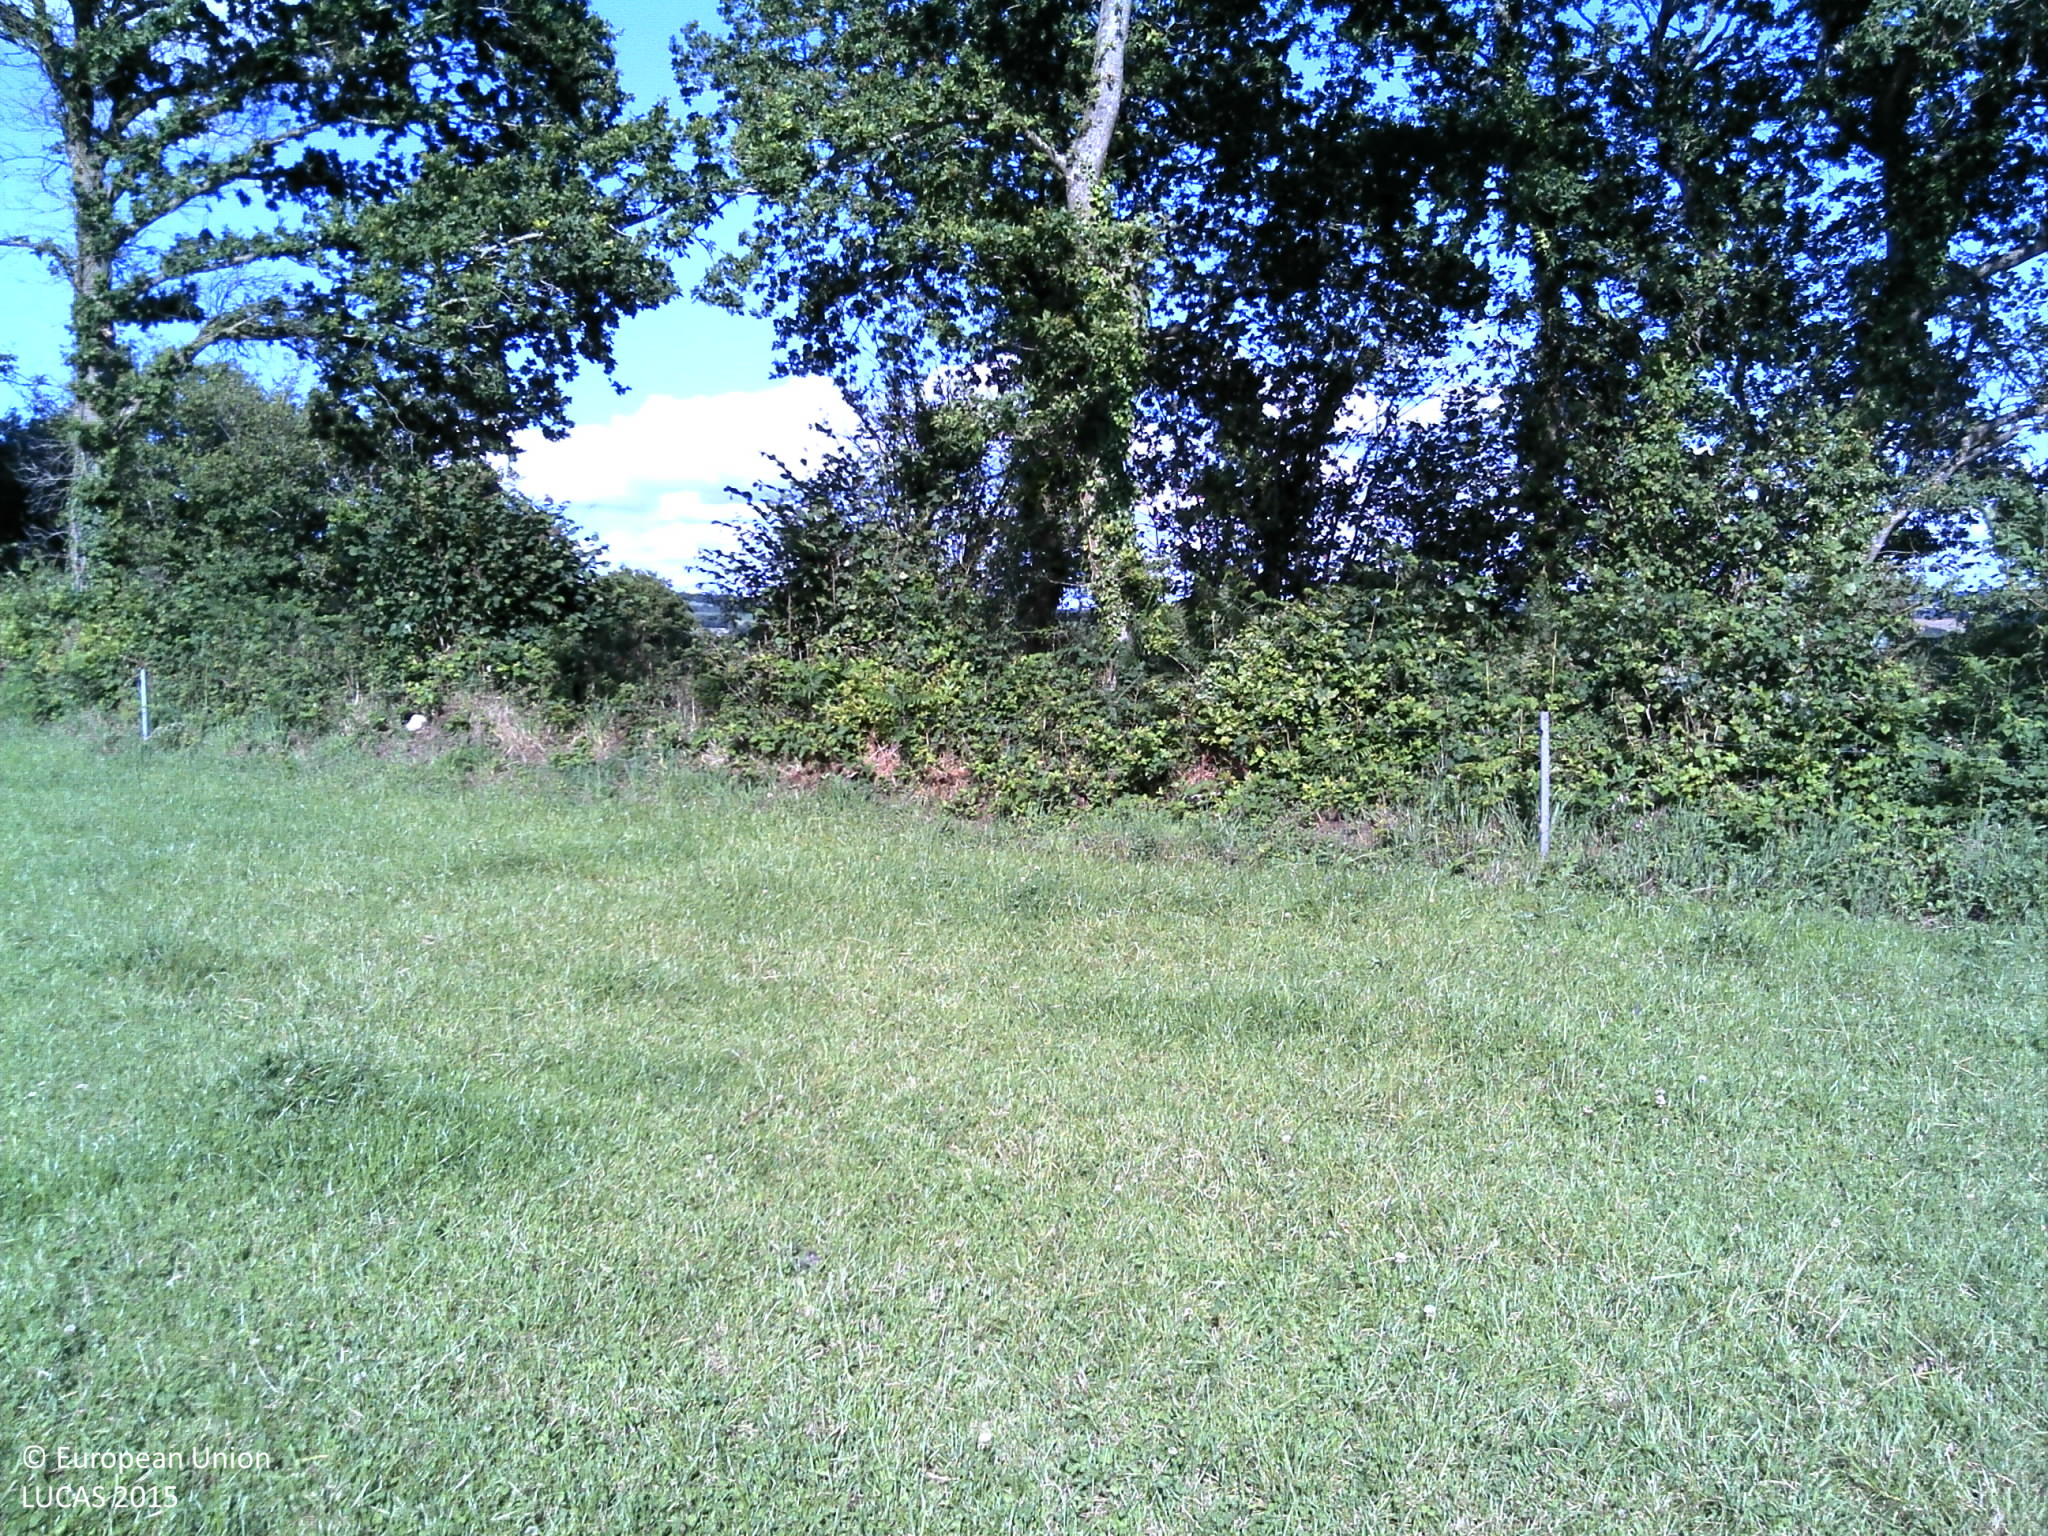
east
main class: Grassland
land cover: Grassland without tree/shrub cover
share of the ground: > 75 %
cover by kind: herbaceous plants 100 %
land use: Agriculture (excluding fallow land and kitchen gardens)
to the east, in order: Grassland without tree/shrub cover; Fences; Broadleaved woodland; Ditches and canals; Paved roads, cycling and walking lanes; Ditches and canals; Broadleaved woodland; Fences; Grassland without tree/shrub cover; Fences; Spontaneously vegetated surfaces; Broadleaved woodland
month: July
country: FR
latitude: 48.4724
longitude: -3.7314
